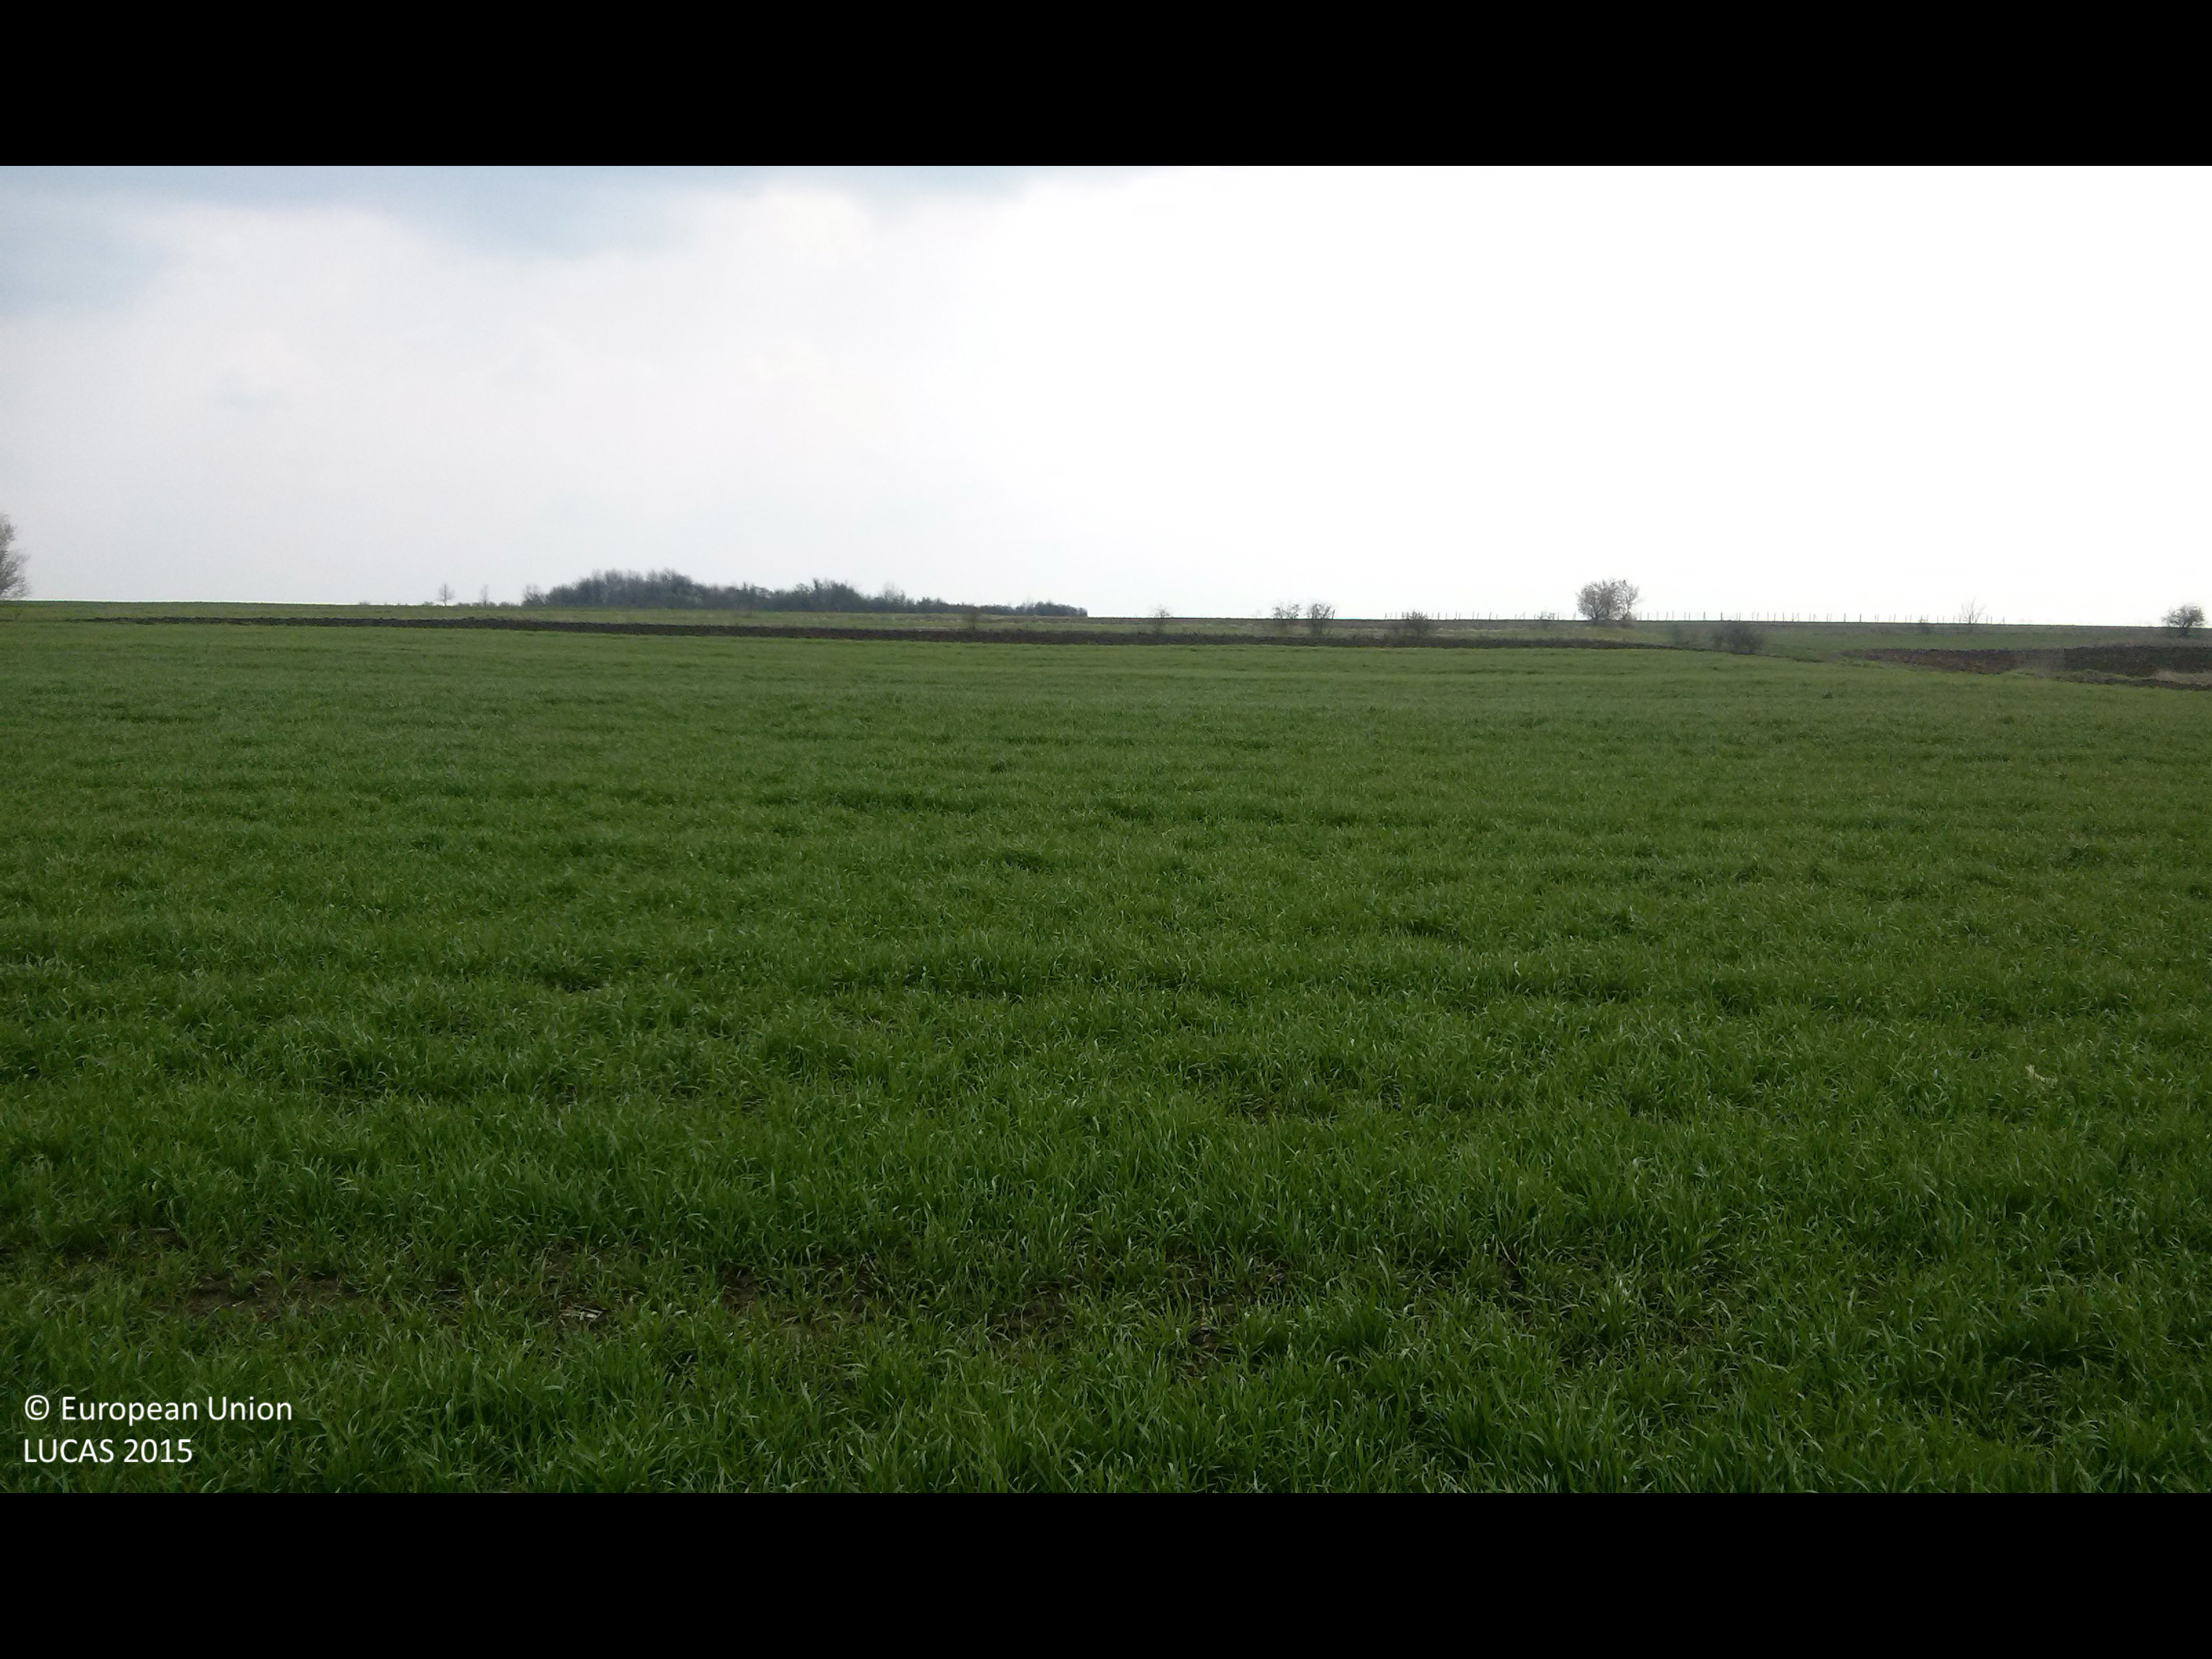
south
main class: Cropland
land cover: Oats
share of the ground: < 10 %
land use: Agriculture (excluding fallow land and kitchen gardens)
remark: Harvested field
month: June
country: BG
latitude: 43.3951
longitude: 26.8917
